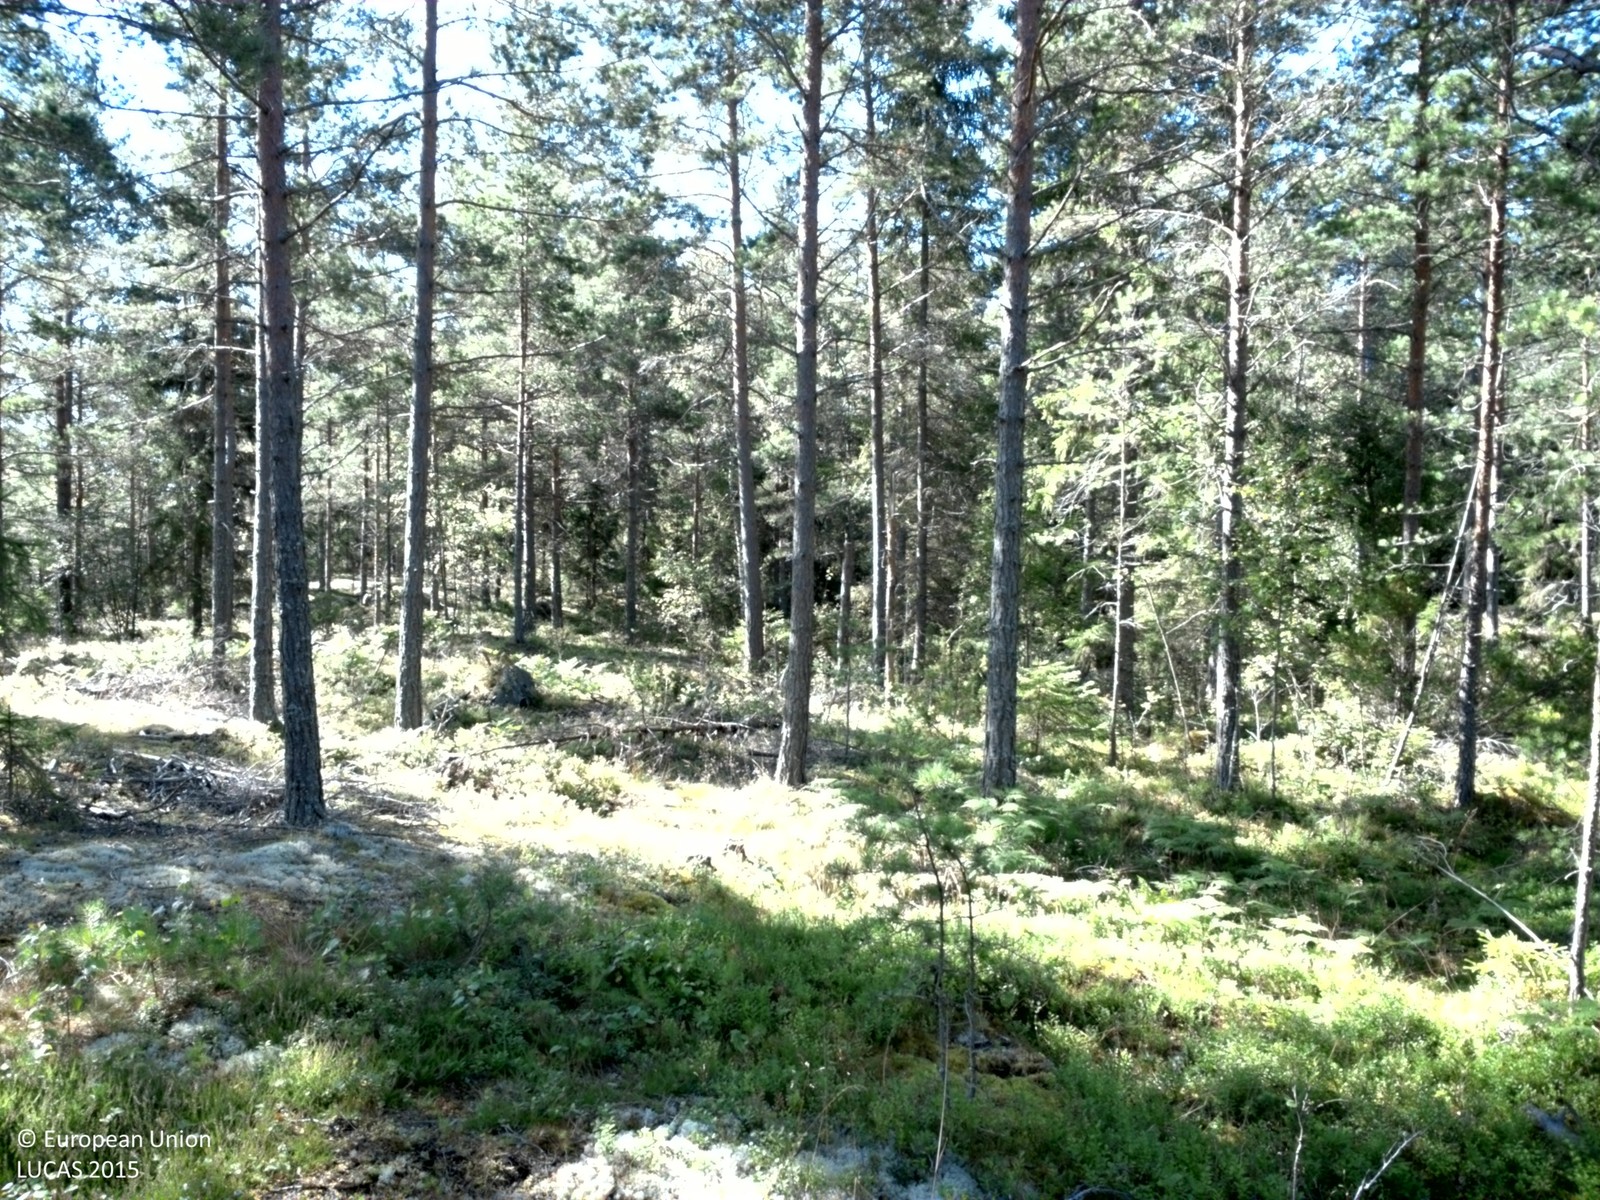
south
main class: Woodland
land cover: Pine dominated coniferous woodland
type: boreal forest
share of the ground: 25 - 50 %
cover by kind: lichens and mosses 45 %, coniferous forest trees 40 %, broadleaved forest trees 5 %, shrubs 5 %, consolidated bare surface 5 %
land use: Forestry
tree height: > 5 m
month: August
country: SE
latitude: 59.5587
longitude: 18.5468
